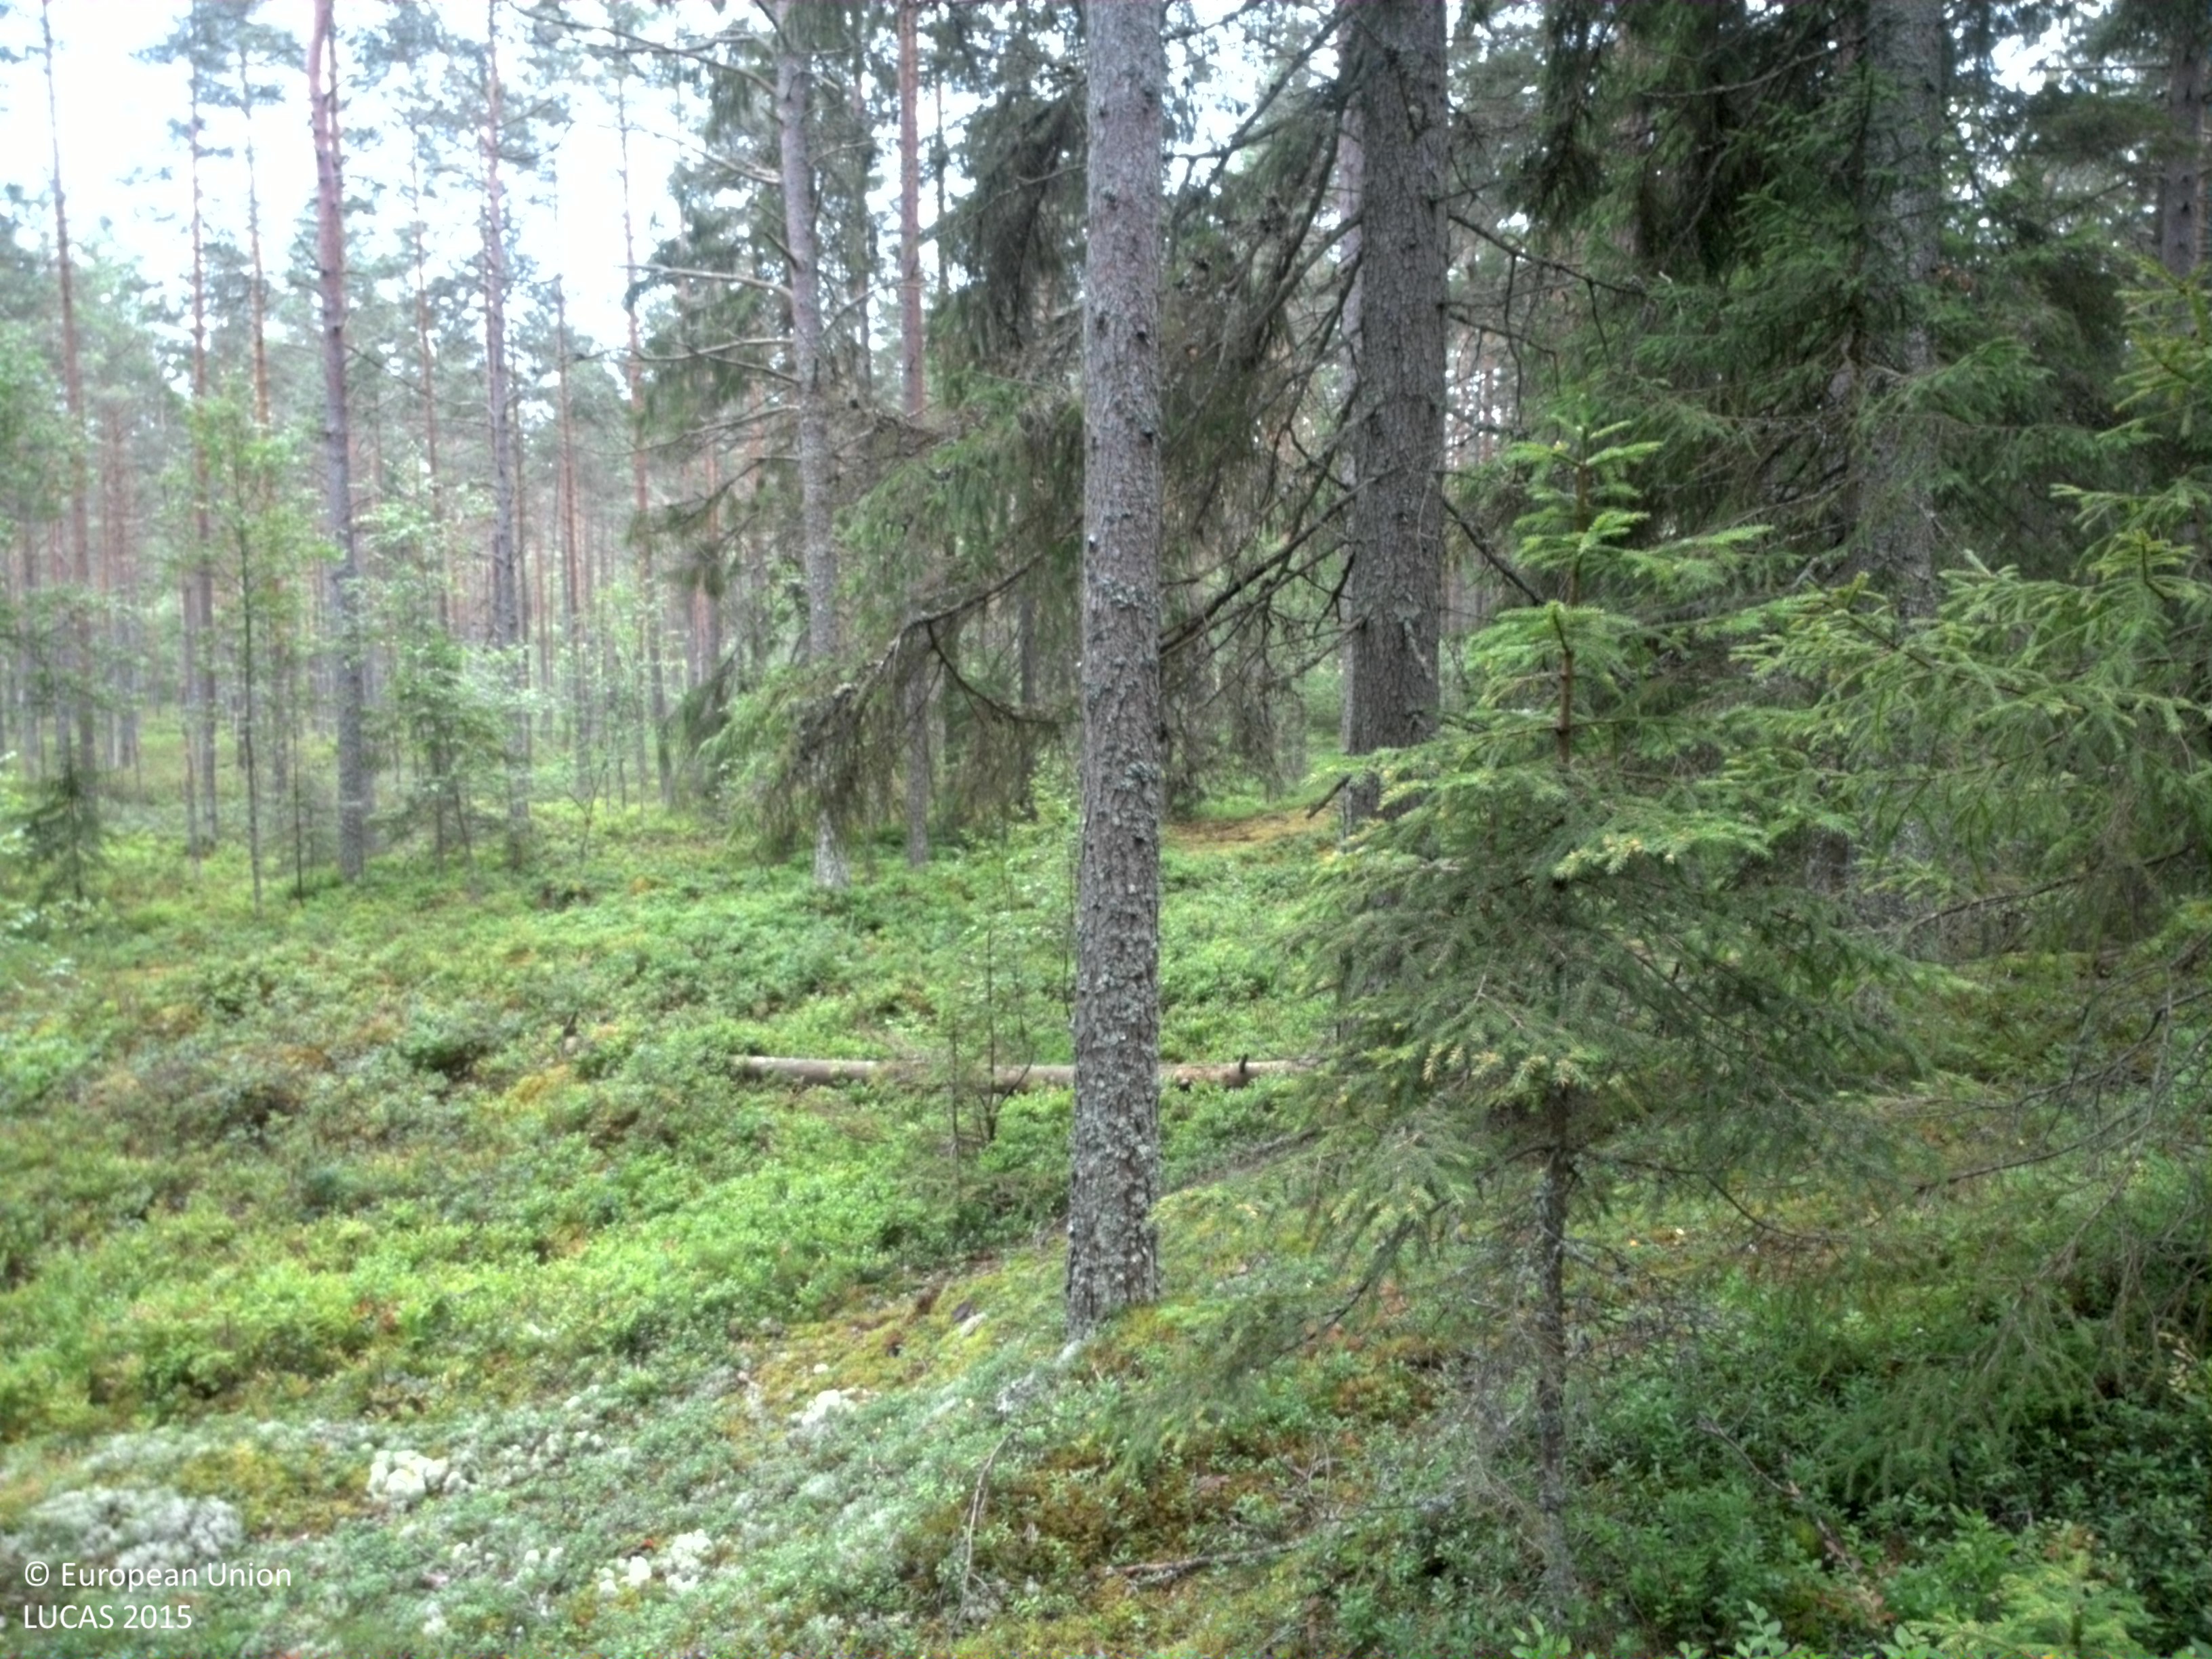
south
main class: Woodland
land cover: Spruce dominated coniferous woodland
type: boreal forest
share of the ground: 50 - 75 %
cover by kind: coniferous forest trees 65 %, shrubs 20 %, lichens and mosses 10 %, broadleaved forest trees 5 %
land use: Forestry
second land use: Amenities, museums, leisure
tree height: > 5 m
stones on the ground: 25 - 50 %
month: July
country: SE
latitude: 59.4030
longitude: 13.3213
